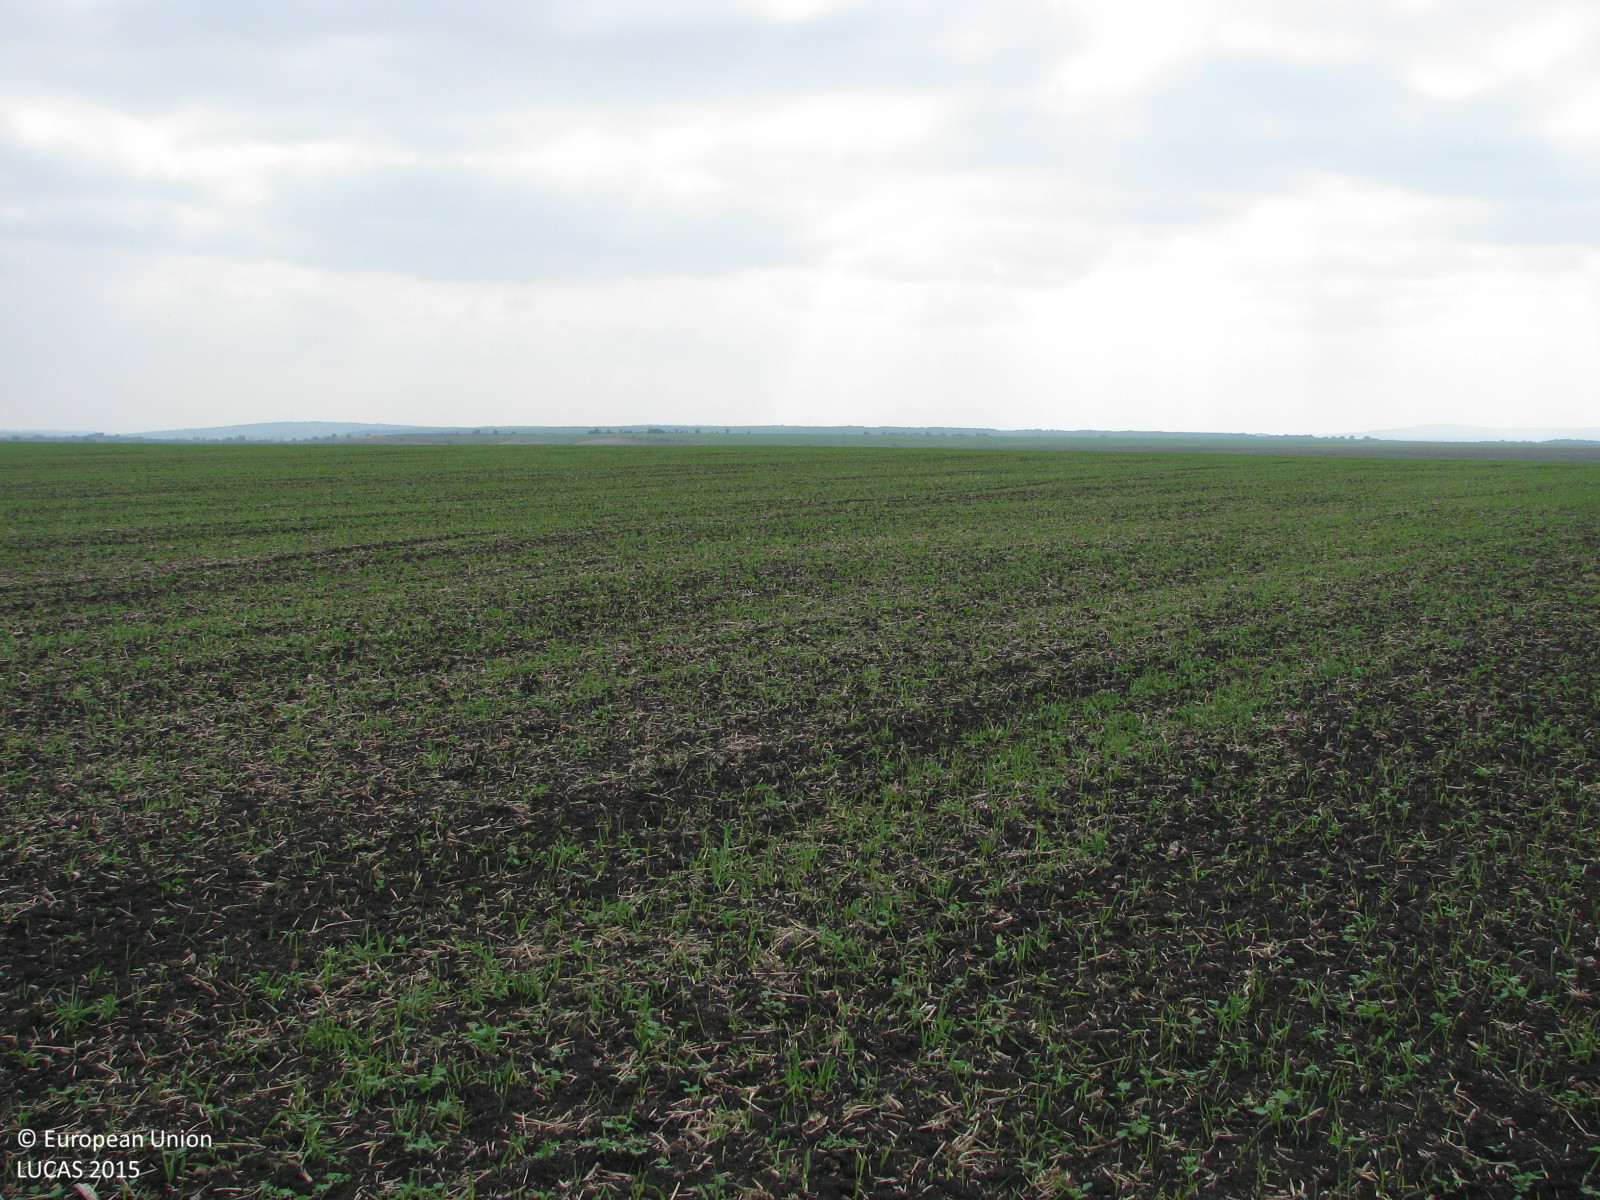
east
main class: Cropland
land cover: Rape and turnip rape
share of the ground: 10 - 25 %
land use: Agriculture (excluding fallow land and kitchen gardens)
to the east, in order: Rape and turnip rape
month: October
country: BG
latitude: 42.3012
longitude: 26.5019
